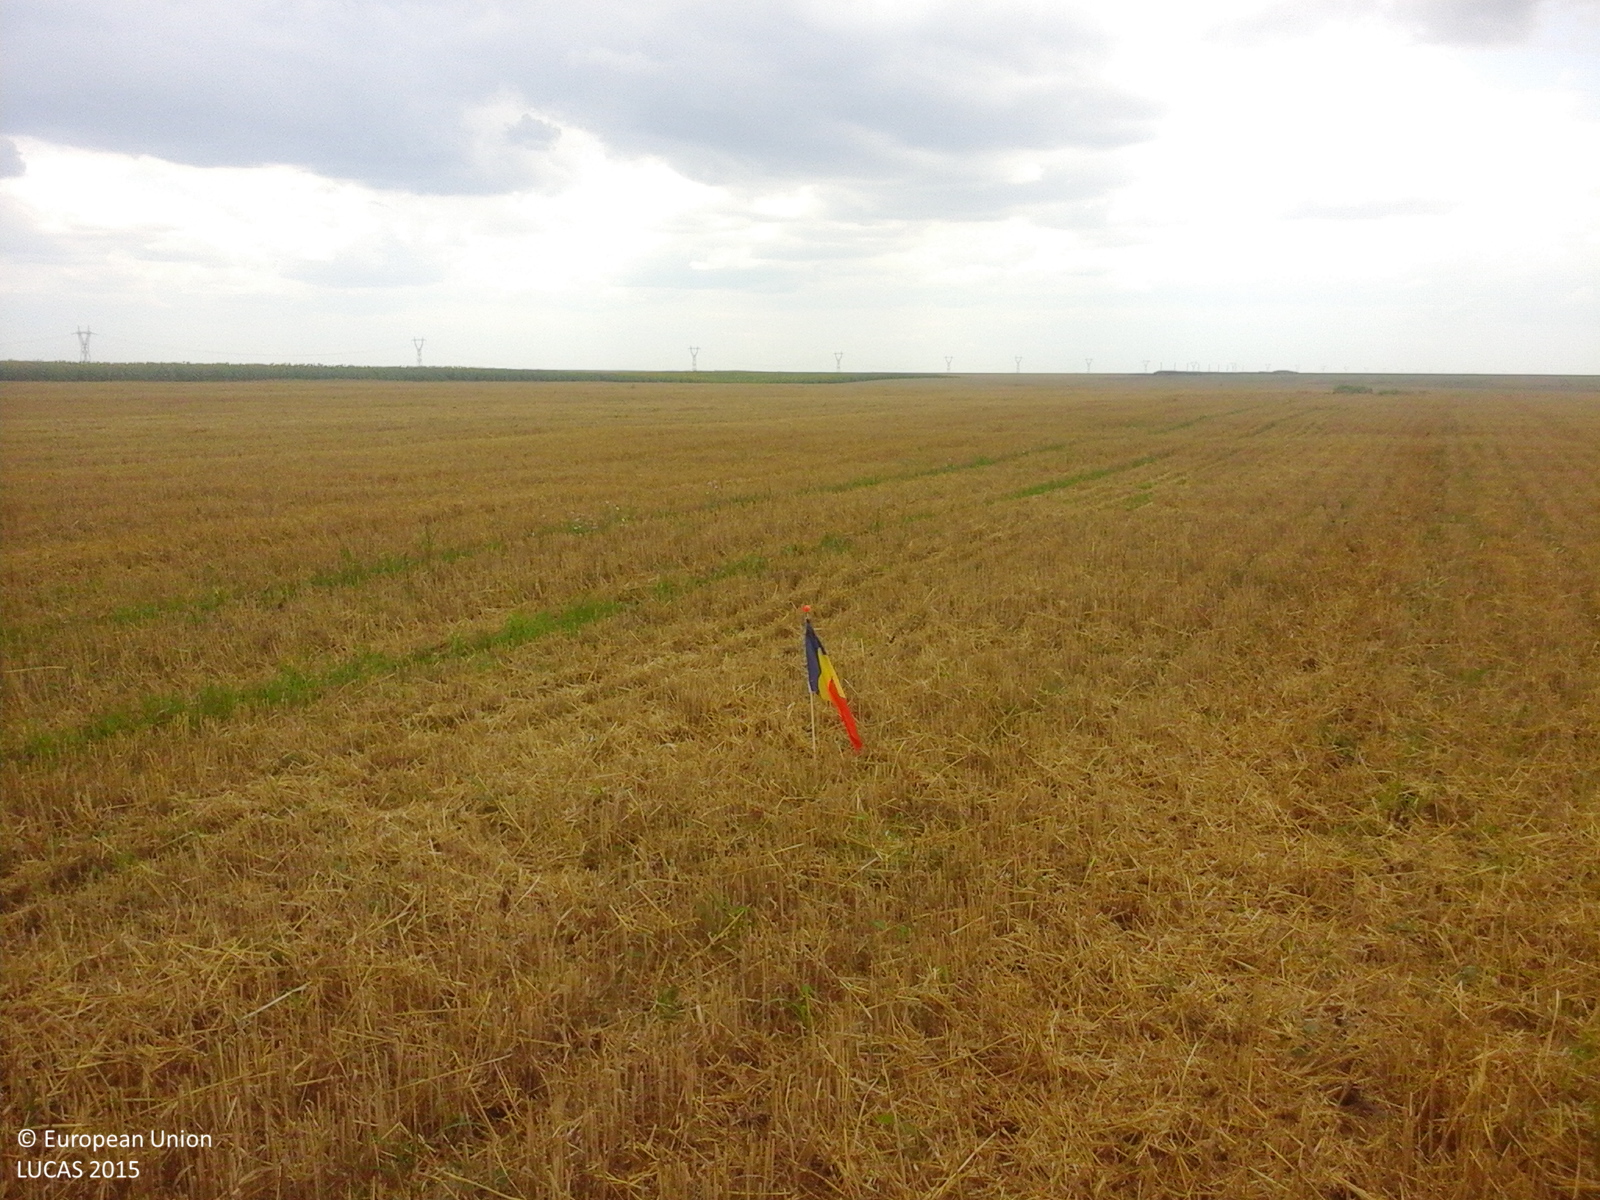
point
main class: Cropland
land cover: Common wheat
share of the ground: < 10 %
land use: Agriculture (excluding fallow land and kitchen gardens)
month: July
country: RO
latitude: 43.8753
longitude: 25.2505
